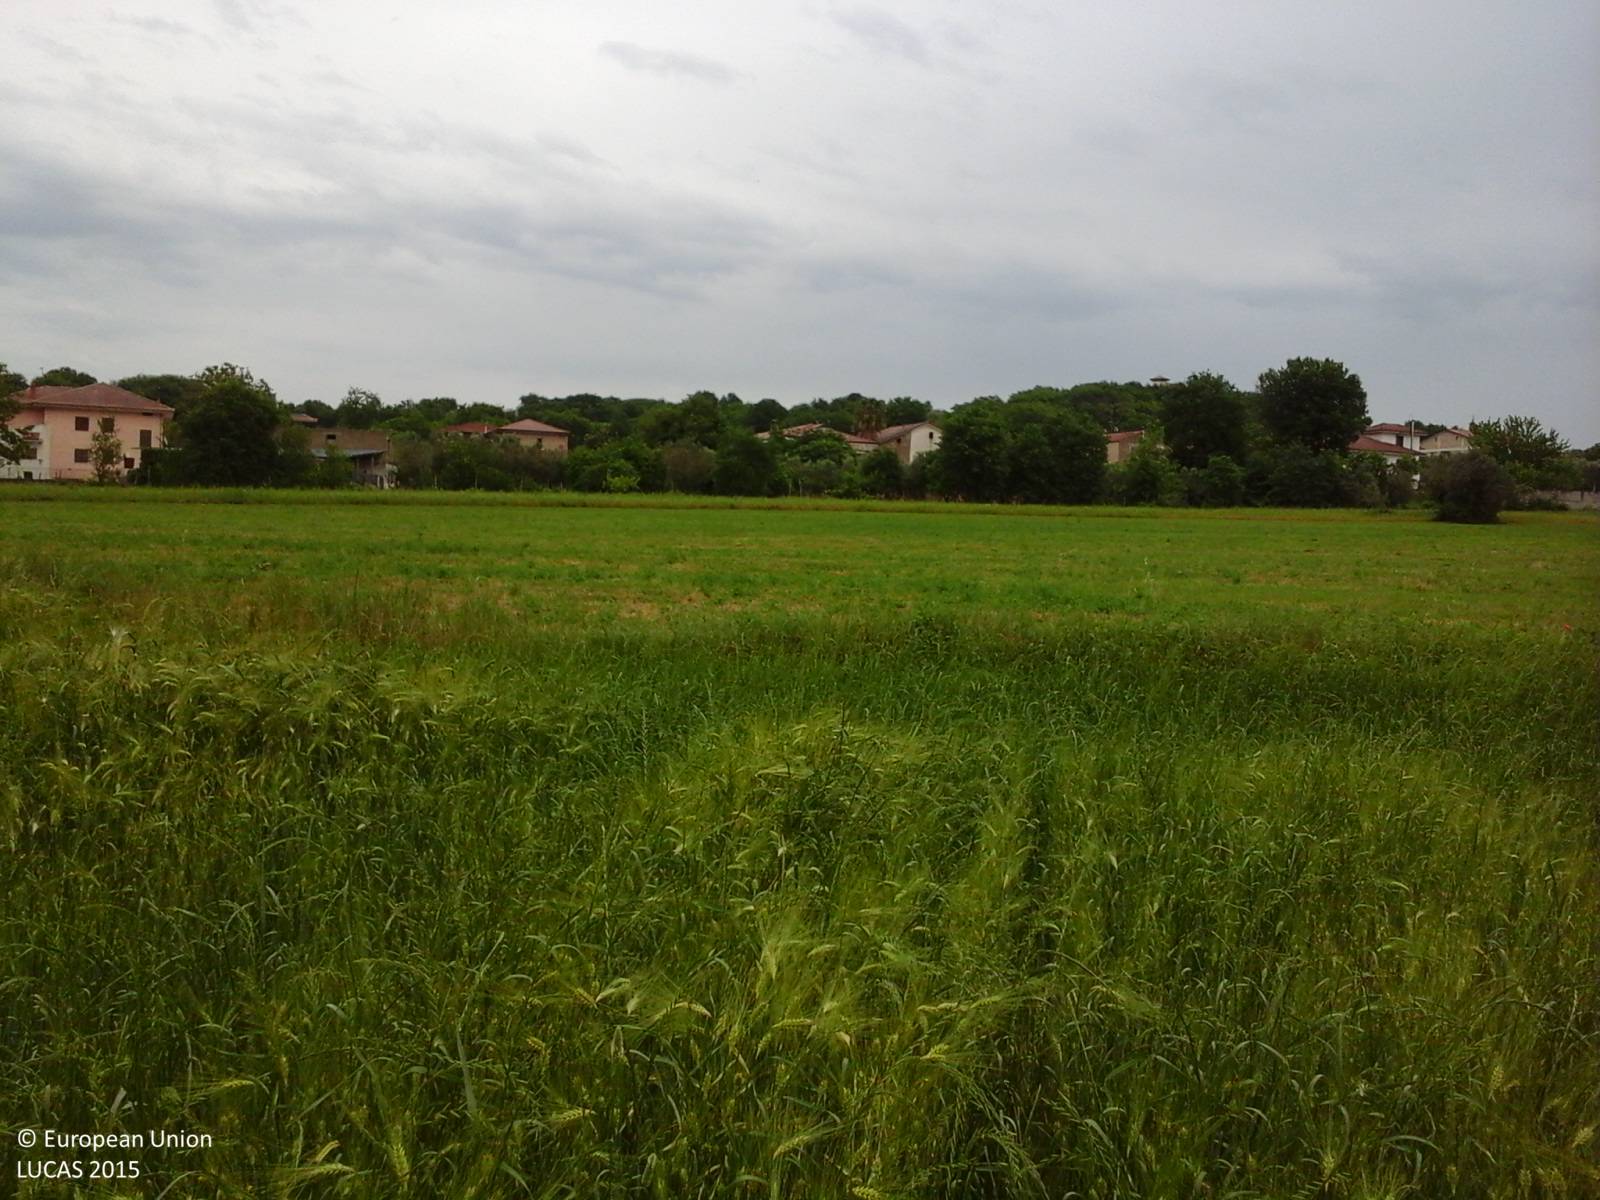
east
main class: Cropland
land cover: Barley
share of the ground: > 75 %
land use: Agriculture (excluding fallow land and kitchen gardens)
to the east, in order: Barley; Grass margins; Temporary grasslands; Single bushes/trees; Vineyards; Olive groves; Lines of trees; Spontaneously vegetated surfaces; Artificial constructions in urban areas
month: May
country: IT
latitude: 41.1489
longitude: 14.3559
